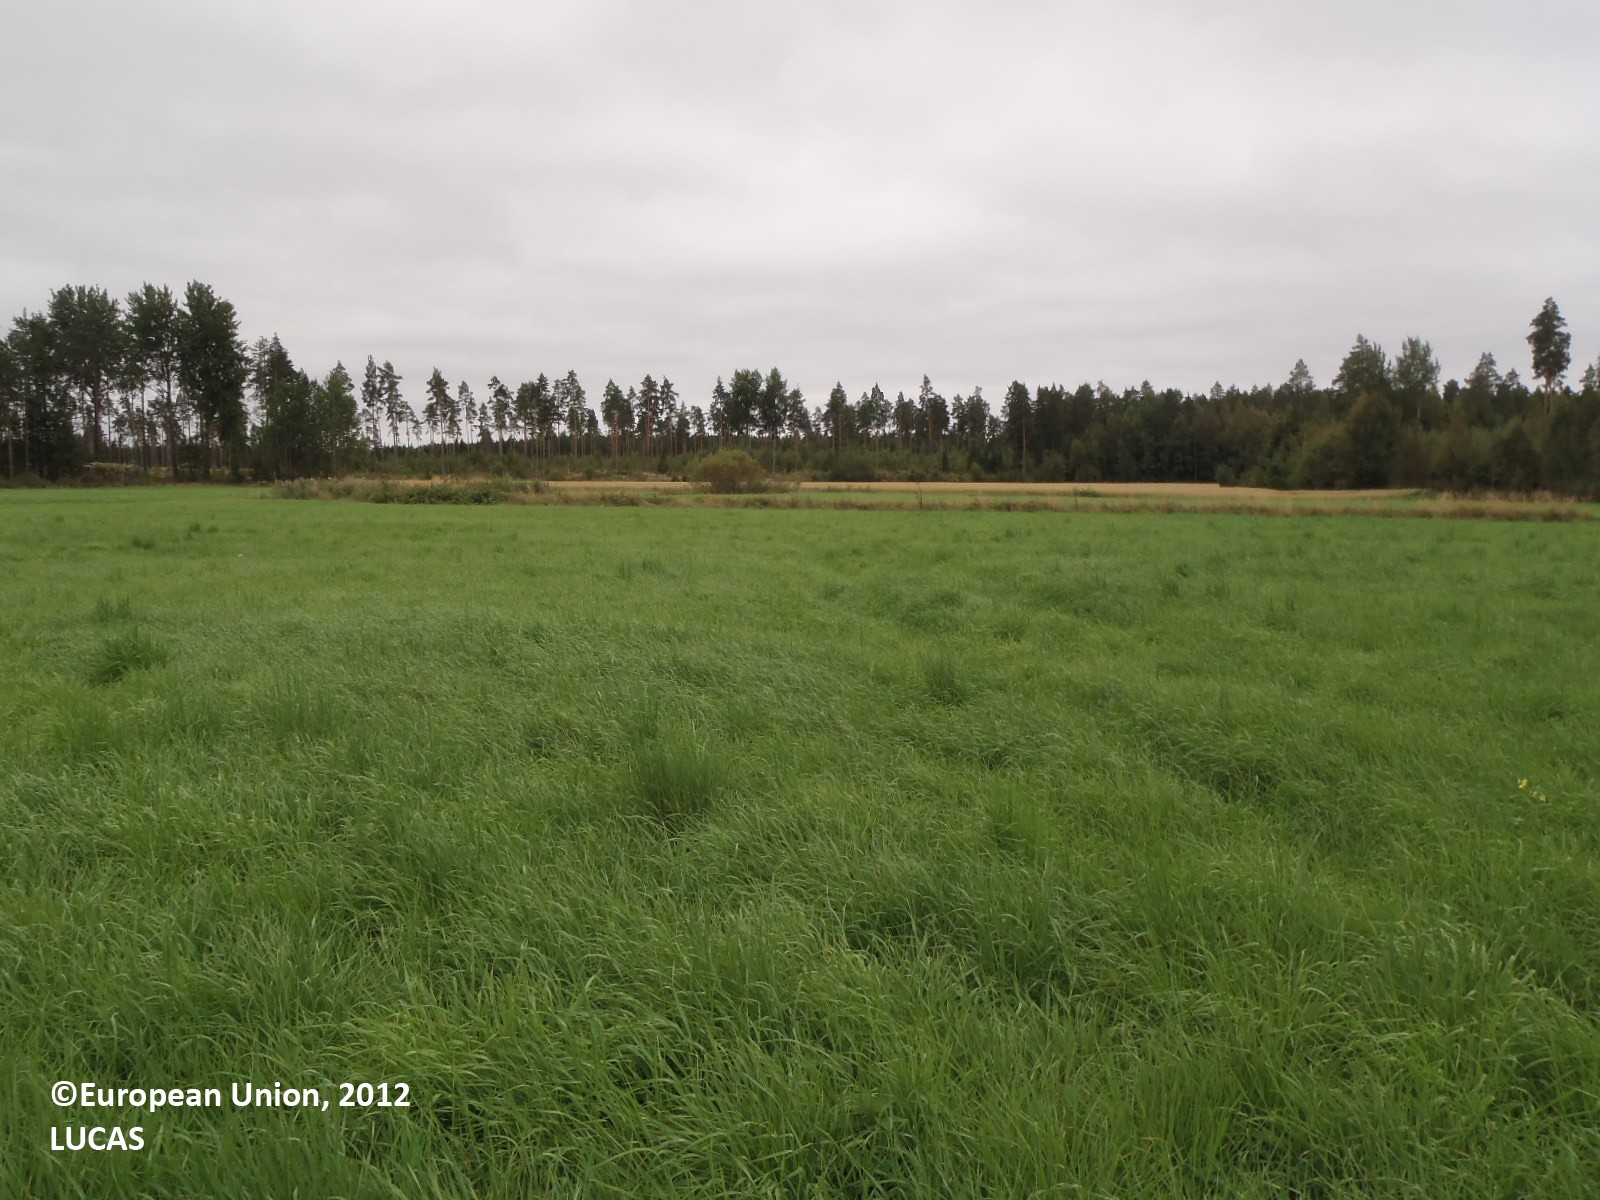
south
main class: Cropland
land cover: Temporary grasslands
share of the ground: > 75 %
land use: Agriculture (excluding fallow land and kitchen gardens)
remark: Harvested field
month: August
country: FI
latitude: 60.8046
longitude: 21.9139
